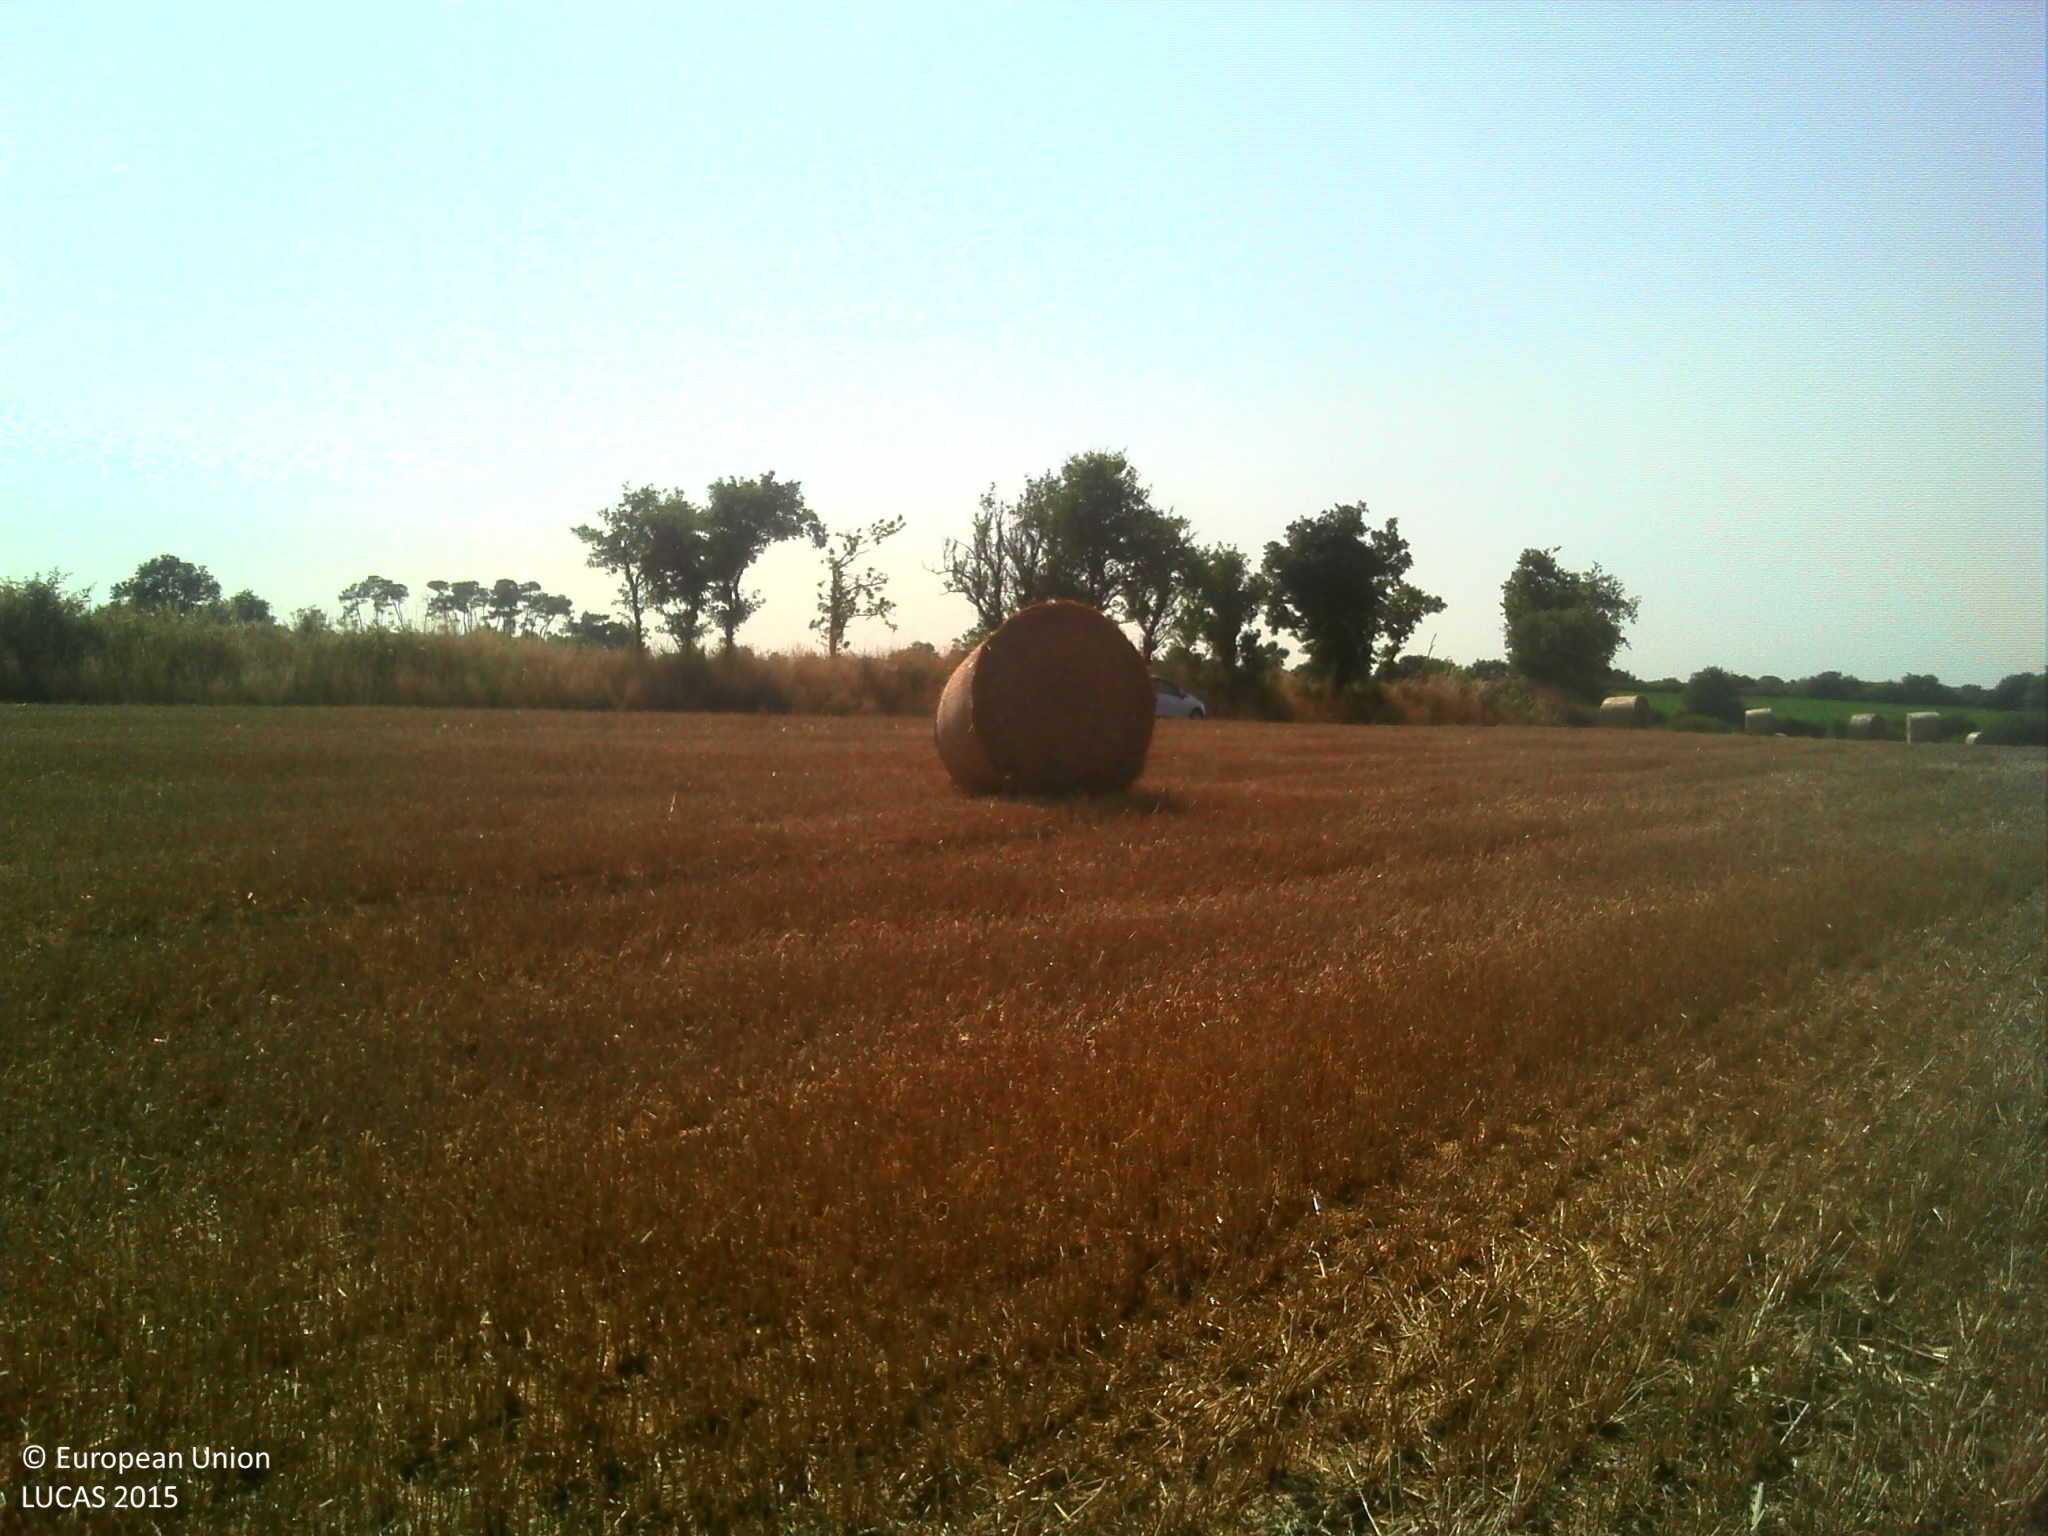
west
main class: Cropland
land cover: Common wheat
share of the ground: > 75 %
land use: Agriculture (excluding fallow land and kitchen gardens)
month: July
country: FR
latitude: 46.5506
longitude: -1.6344
